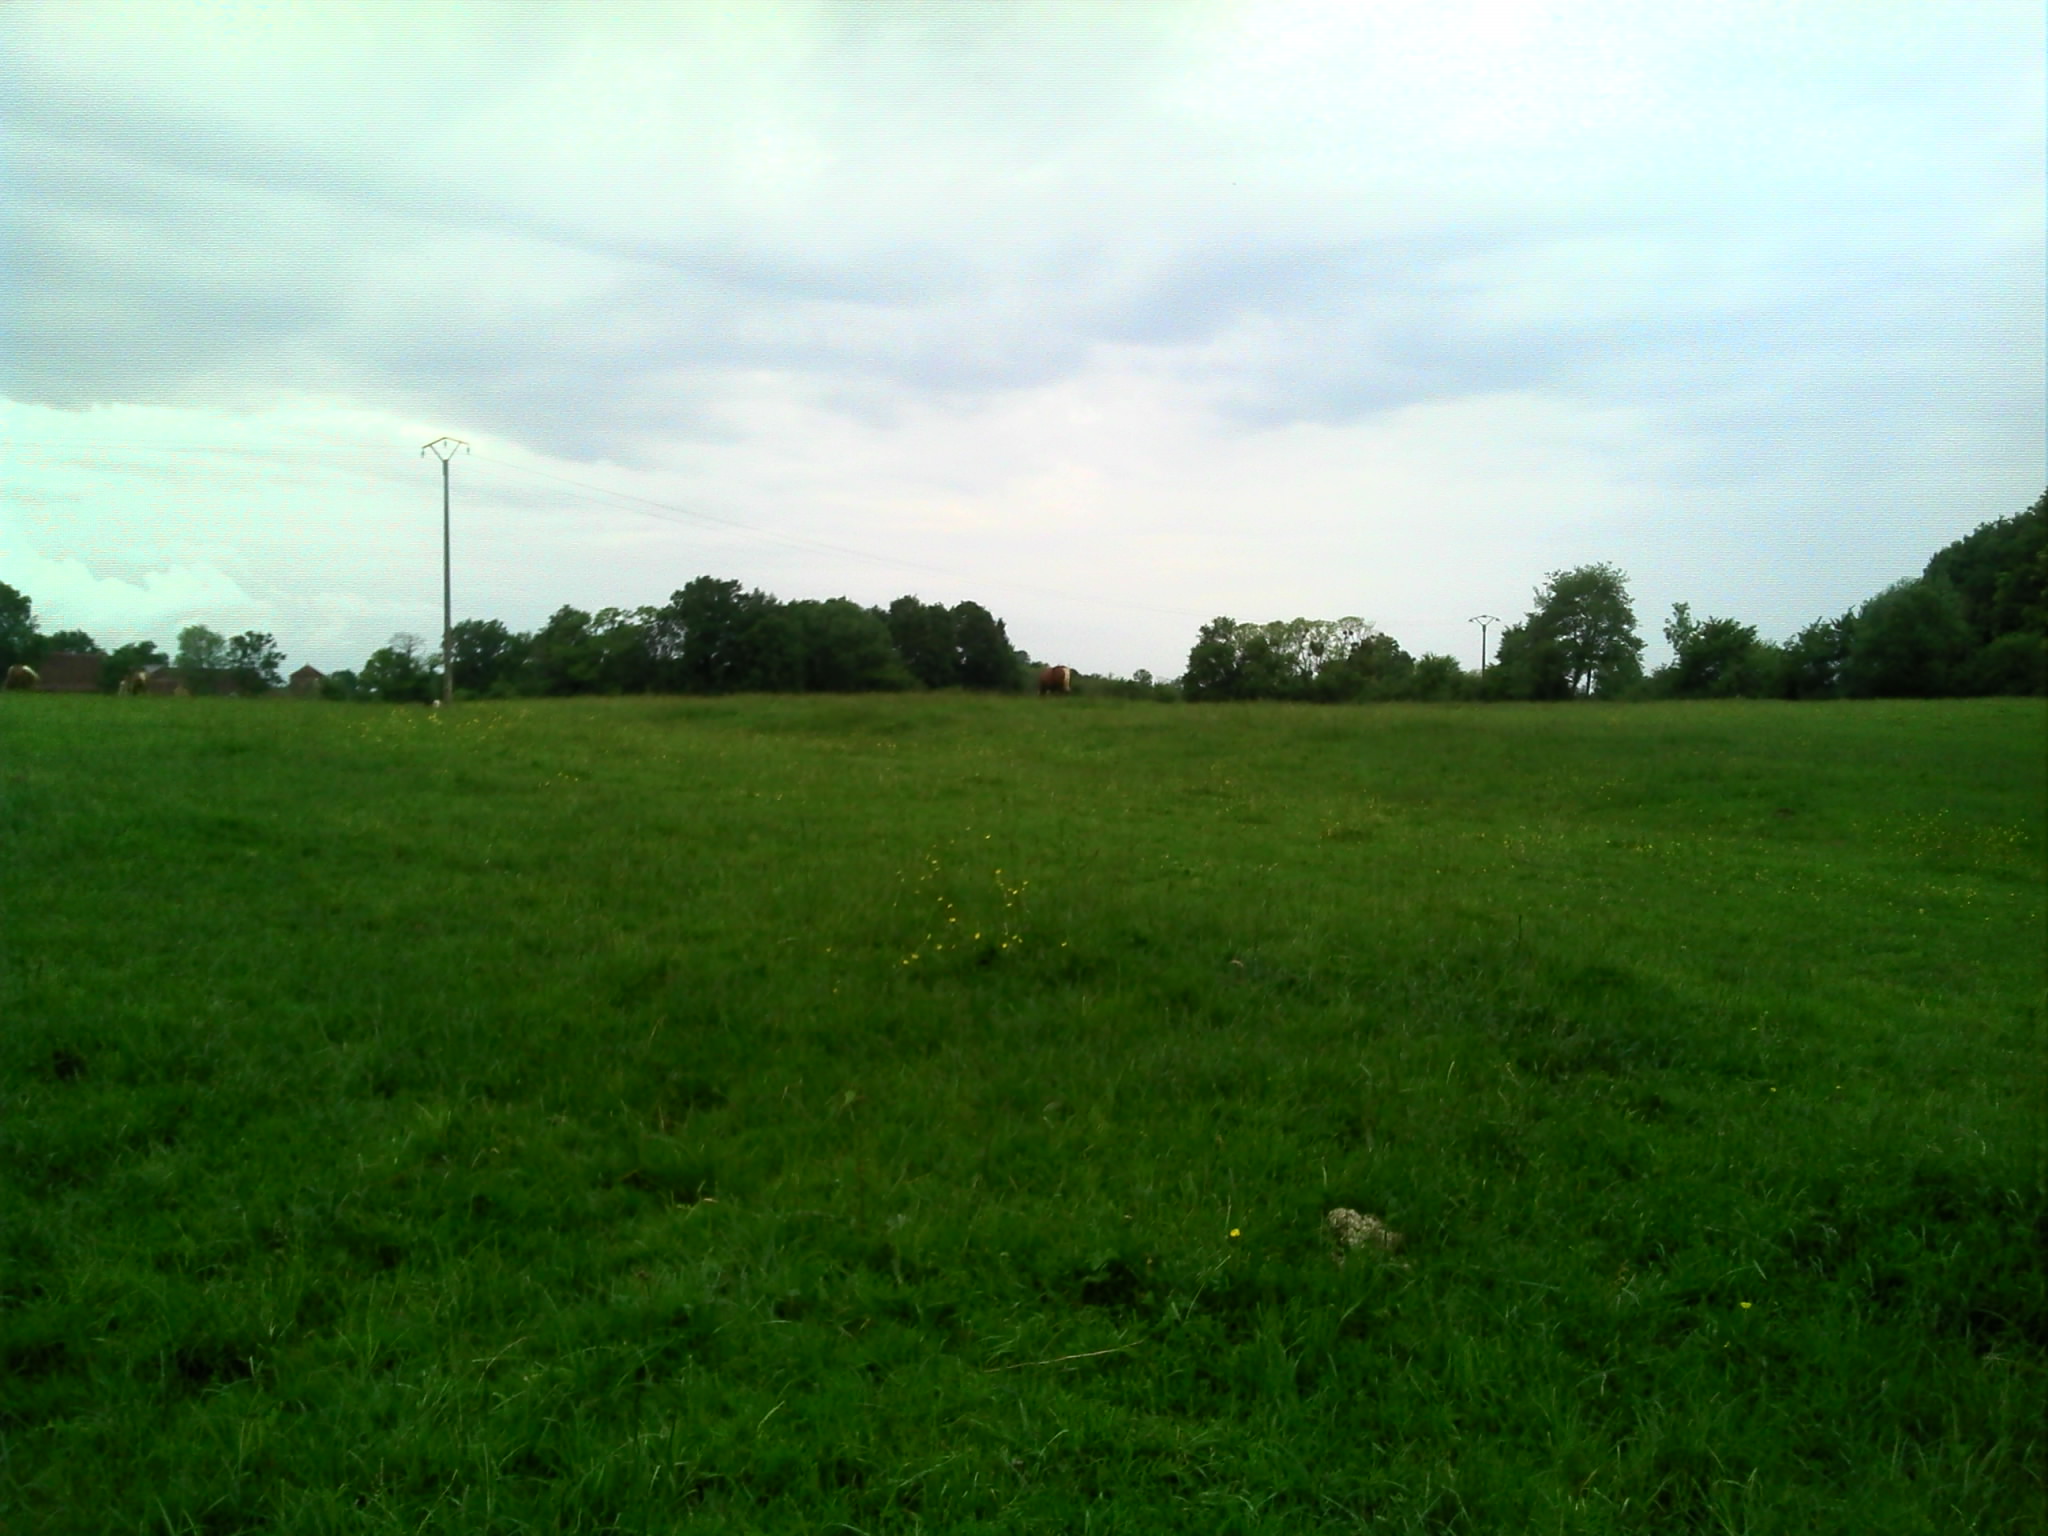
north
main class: Grassland
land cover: Grassland without tree/shrub cover
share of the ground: > 75 %
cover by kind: herbaceous plants 100 %
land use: Agriculture (excluding fallow land and kitchen gardens)
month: May
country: FR
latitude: 46.5386
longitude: 5.3473
